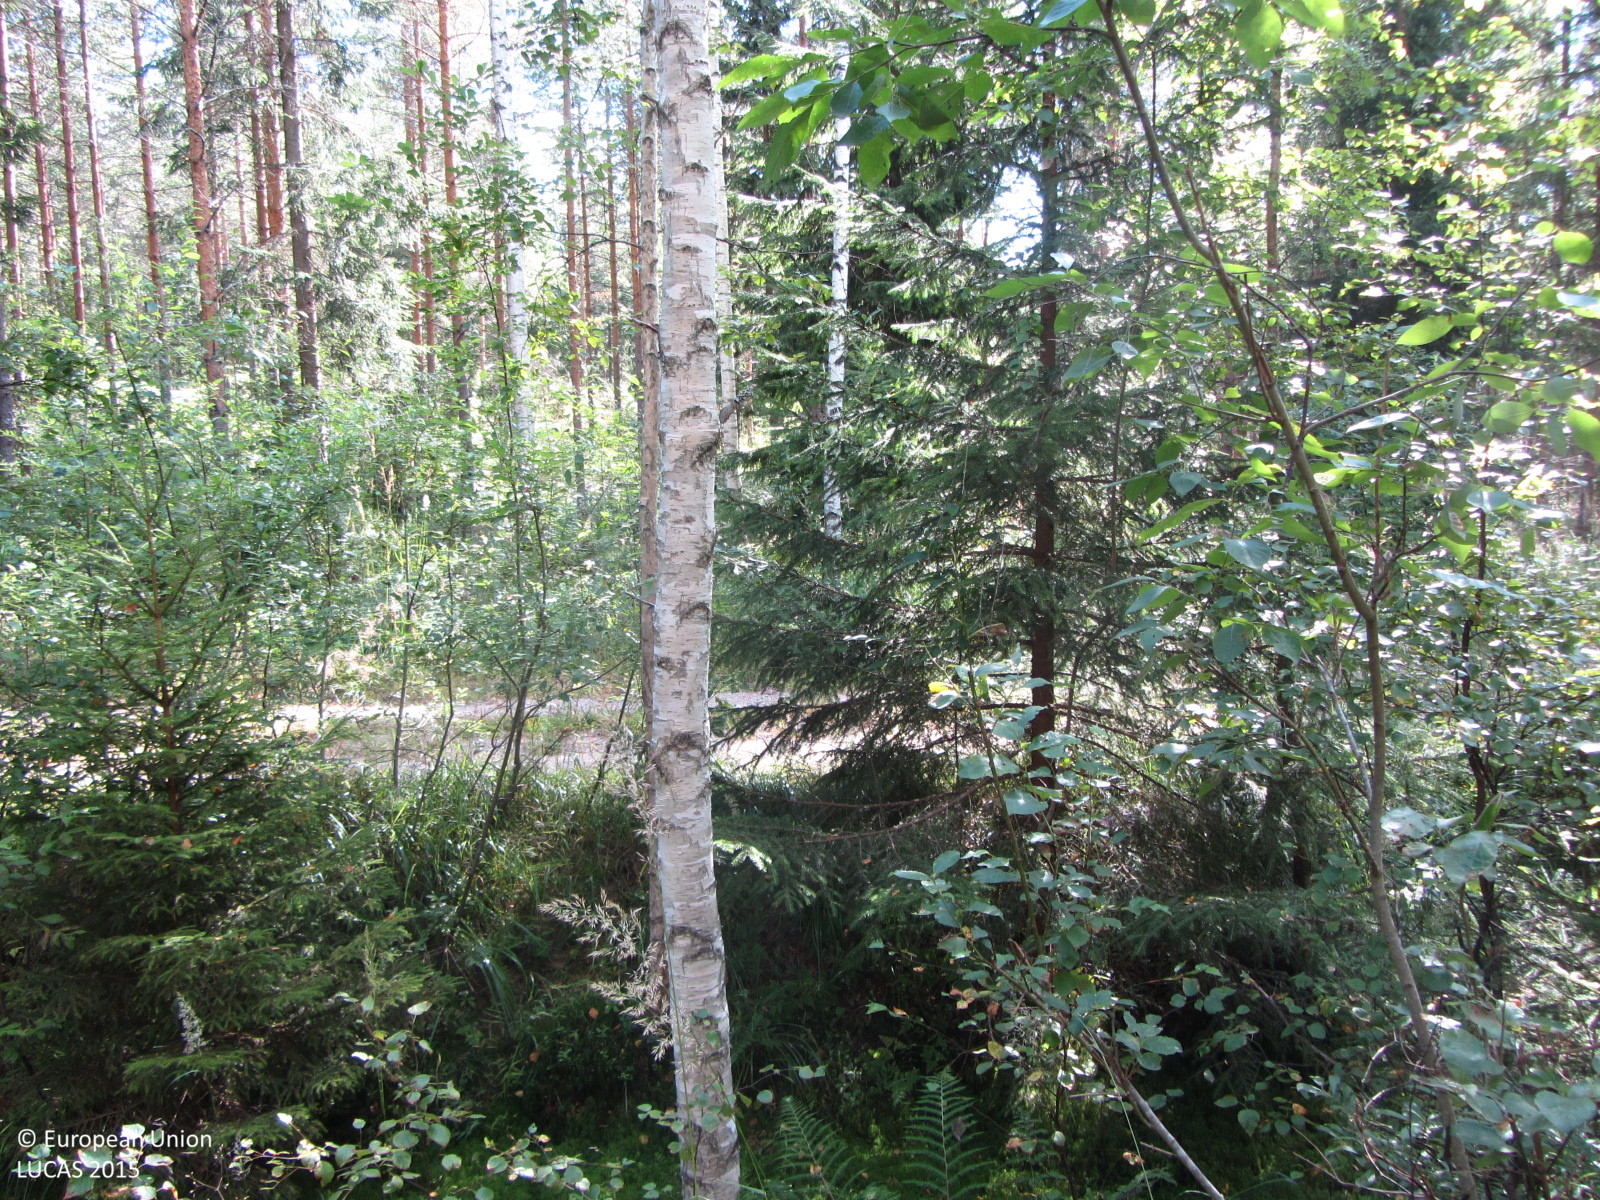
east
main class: Woodland
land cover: Pine dominated mixed woodland
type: boreal forest
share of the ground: 50 - 75 %
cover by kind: coniferous forest trees 50 %, herbaceous plants 25 %, broadleaved forest trees 20 %, shrubs 5 %
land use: Forestry
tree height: > 5 m
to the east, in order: Pine dominated mixed woodland; Ditches and canals; Grass margins; Tracks; Grass margins; Ditches and canals; Pine dominated mixed woodland; Pine dominated coniferous woodland; Spruce dominated coniferous woodland; Spruce dominated mixed woodland
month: August
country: FI
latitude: 60.4061
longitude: 23.5025
